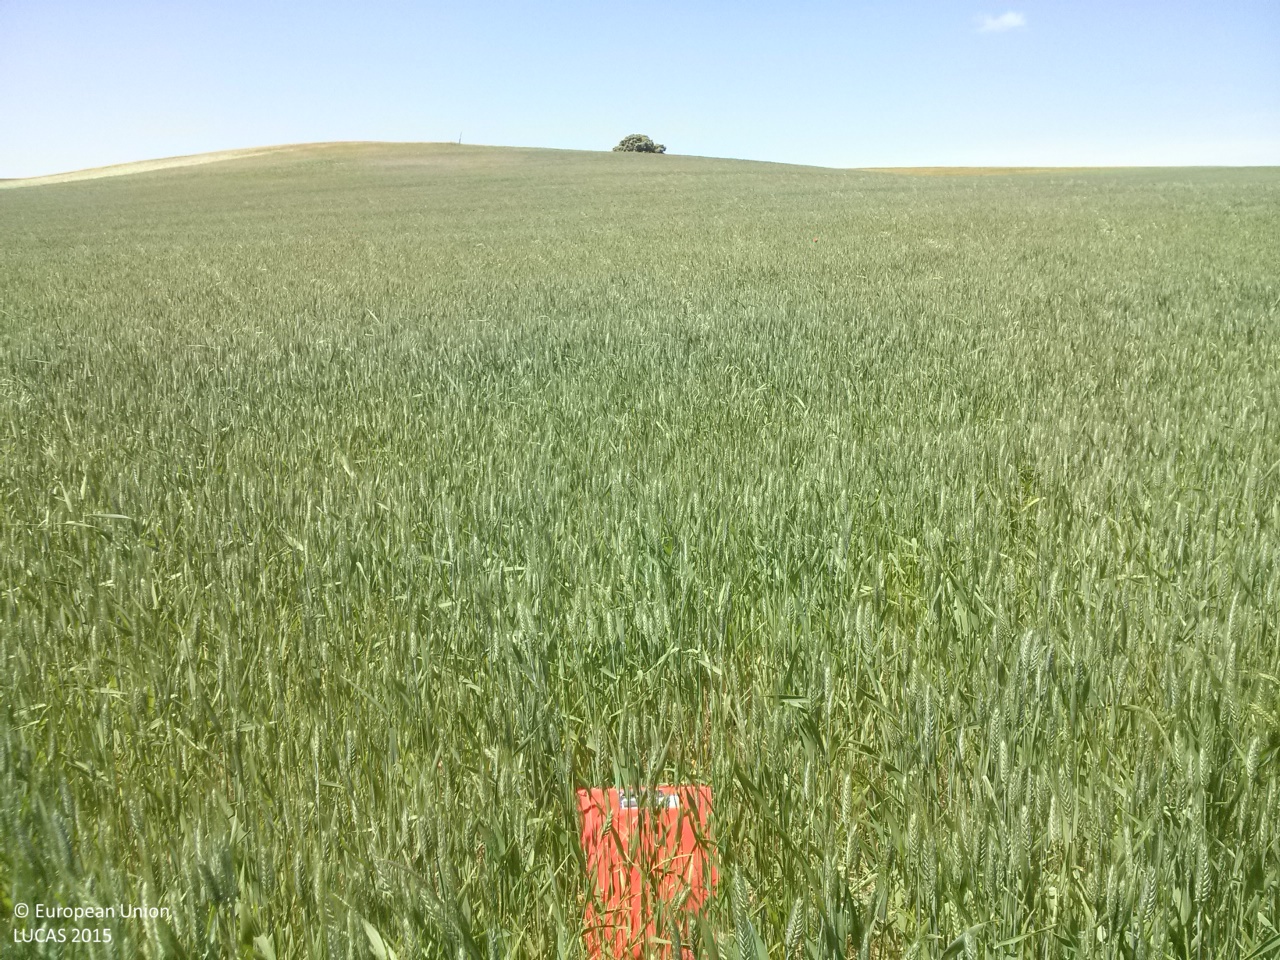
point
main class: Cropland
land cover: Common wheat
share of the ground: > 75 %
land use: Agriculture (excluding fallow land and kitchen gardens)
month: May
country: ES
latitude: 40.1054
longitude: -2.7744
